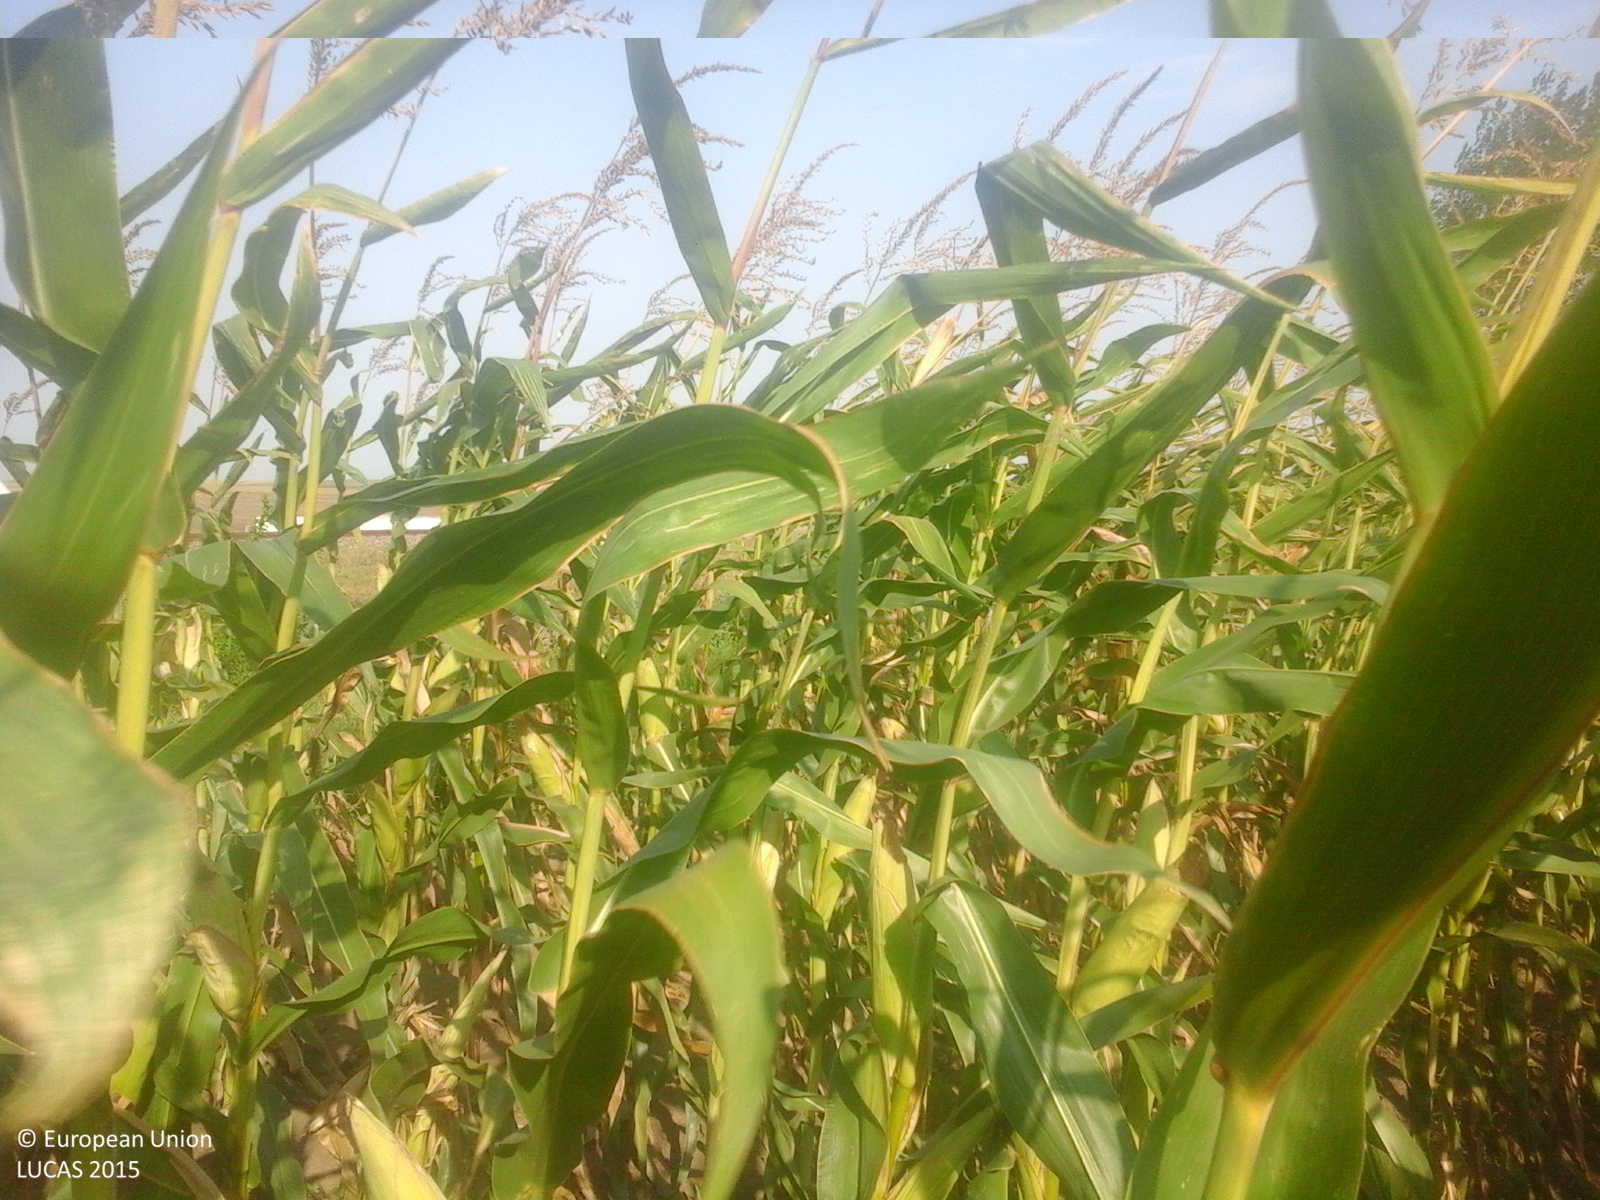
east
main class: Cropland
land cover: Maize
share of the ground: > 75 %
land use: Agriculture (excluding fallow land and kitchen gardens)
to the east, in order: Maize
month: August
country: RO
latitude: 44.0233
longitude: 28.2626
